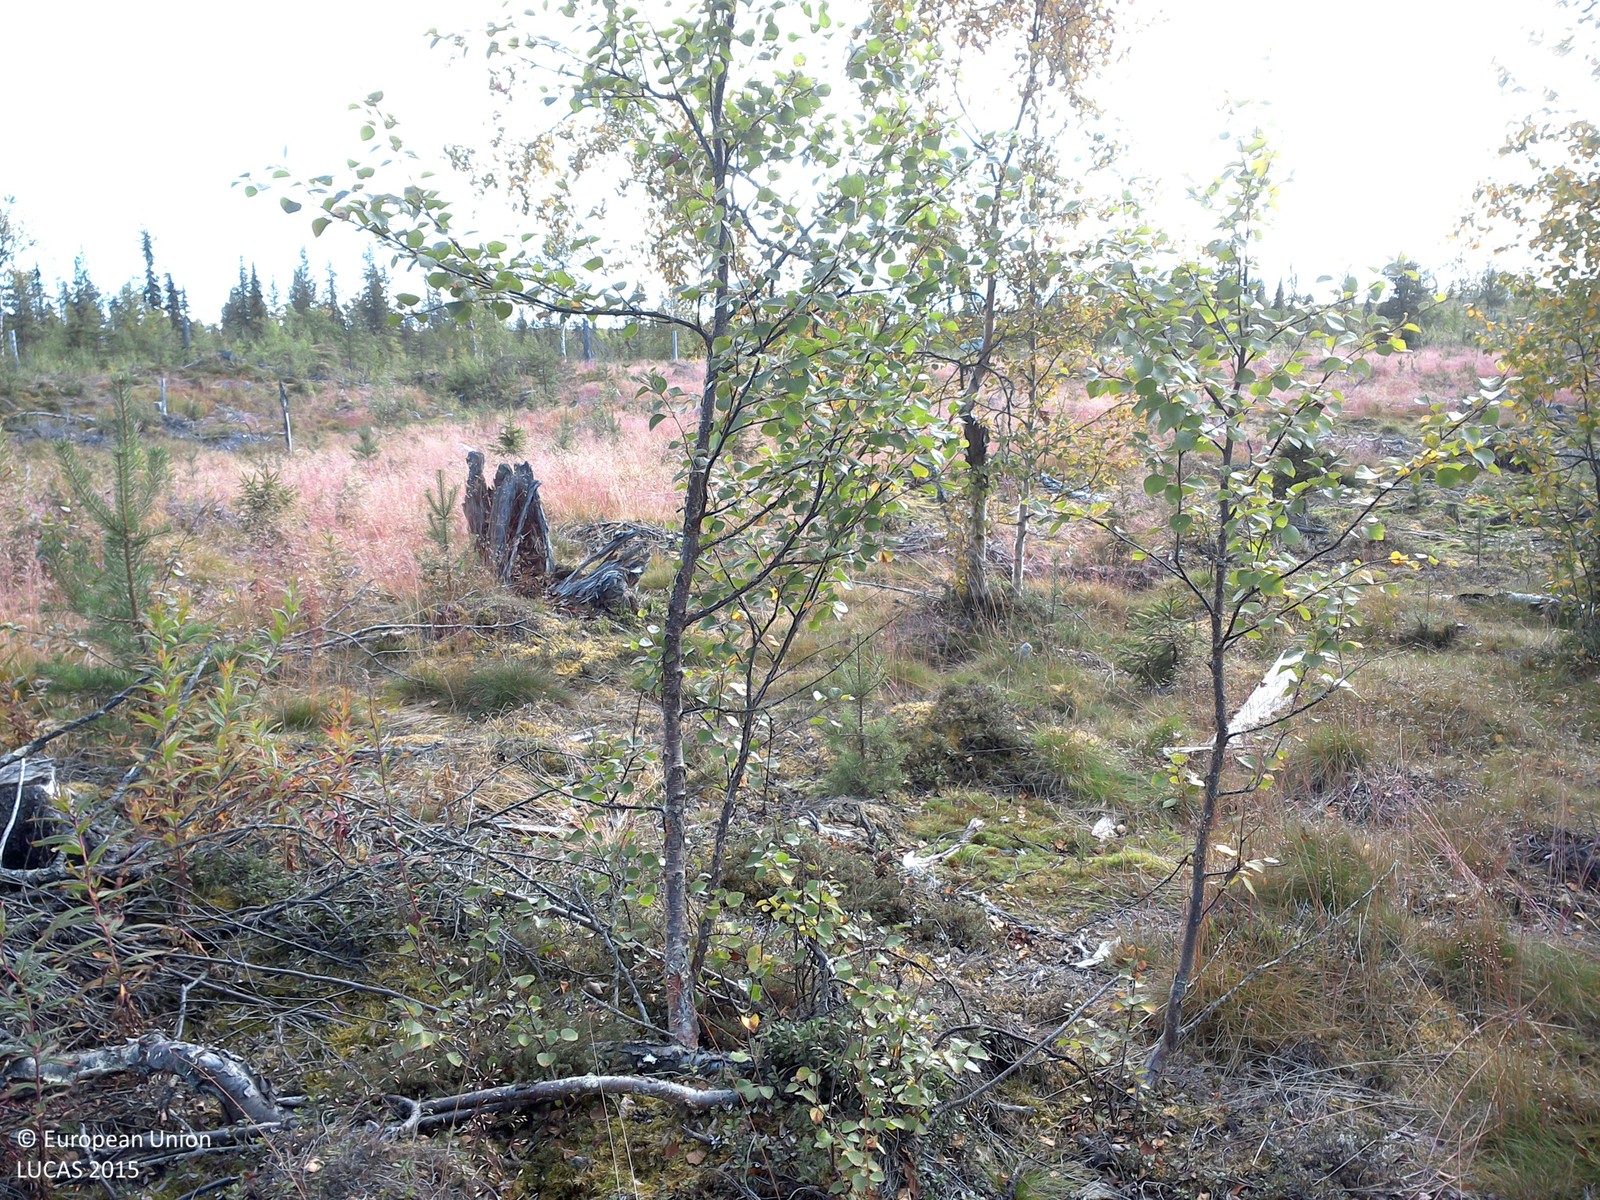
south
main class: Woodland
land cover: Pine dominated mixed woodland
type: boreal forest
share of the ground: 10 - 25 %
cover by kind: herbaceous plants 50 %, shrubs 20 %, lichens and mosses 15 %, coniferous forest trees 5 %, broadleaved forest trees 5 %, consolidated bare surface 5 %
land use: Forestry
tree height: < 5 m
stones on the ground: < 10 %
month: September
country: SE
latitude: 67.8273
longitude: 23.0895
